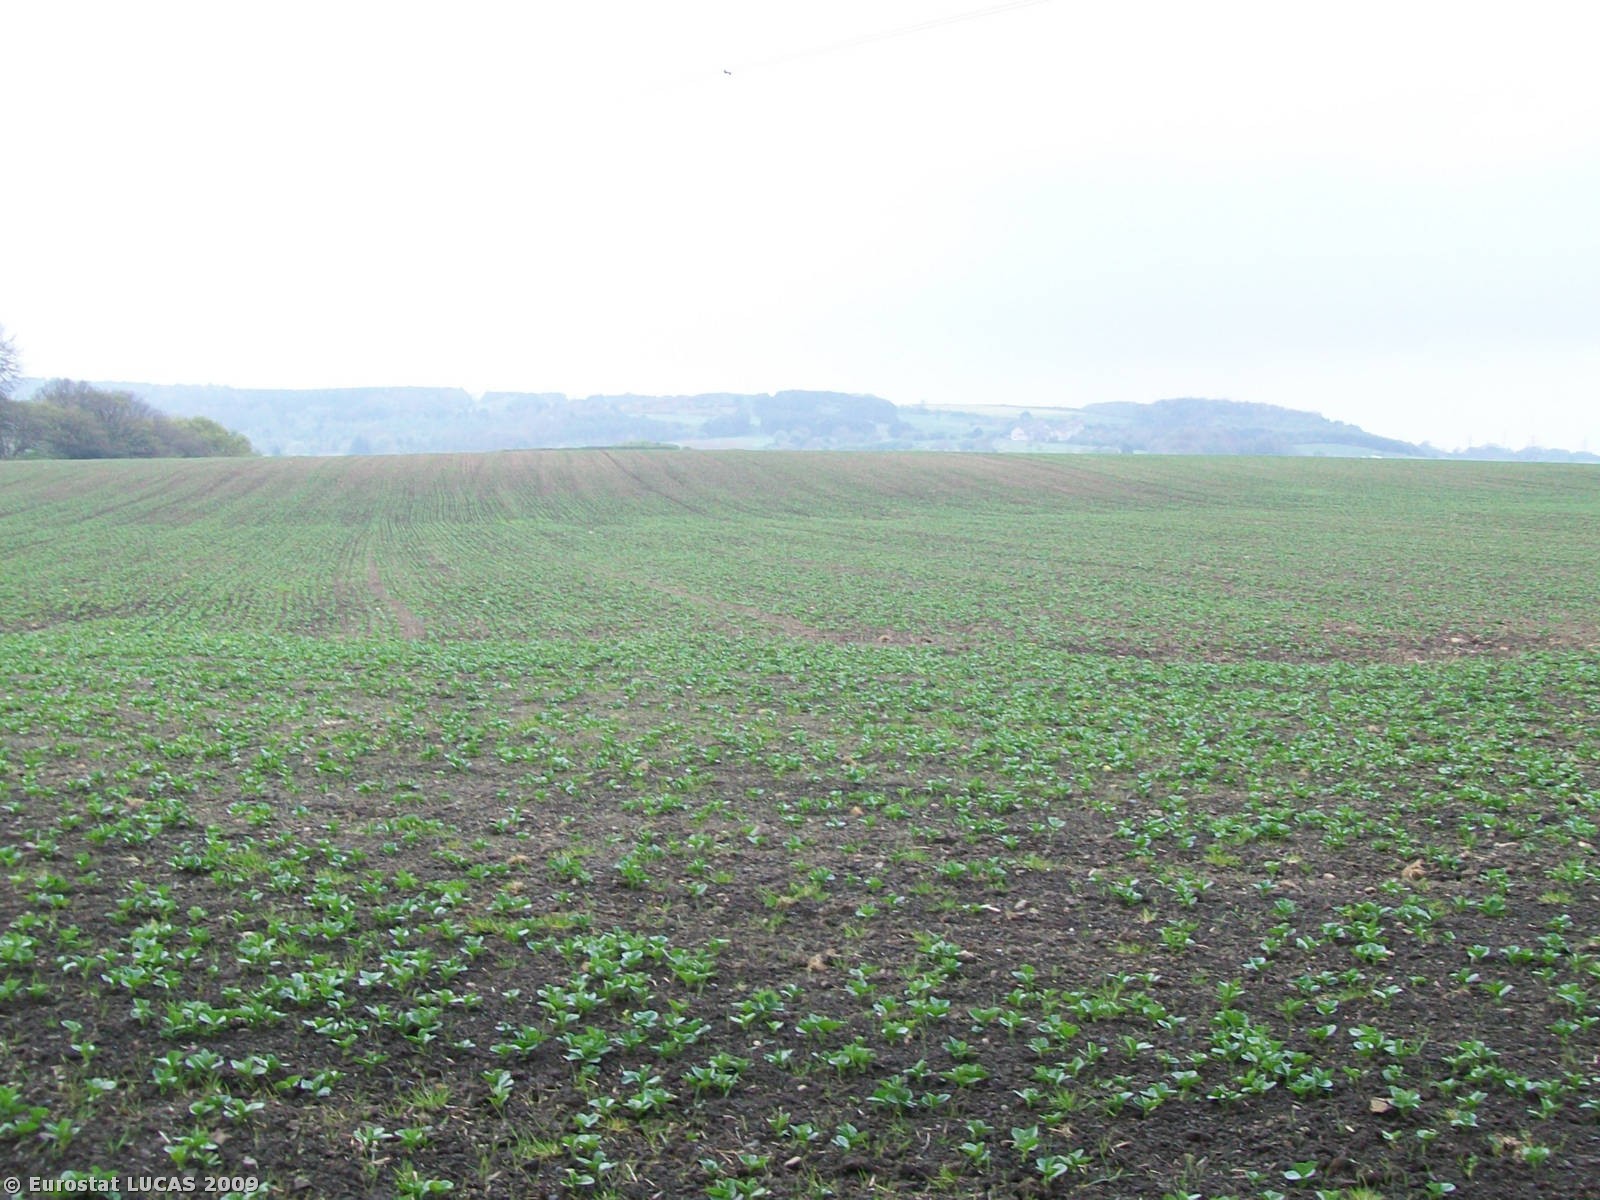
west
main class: Cropland
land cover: Dry pulses
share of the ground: < 10 %
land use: Agriculture (excluding fallow land and kitchen gardens)
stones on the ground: < 10 %
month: April
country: GB
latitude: 54.9343
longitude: -1.7725
